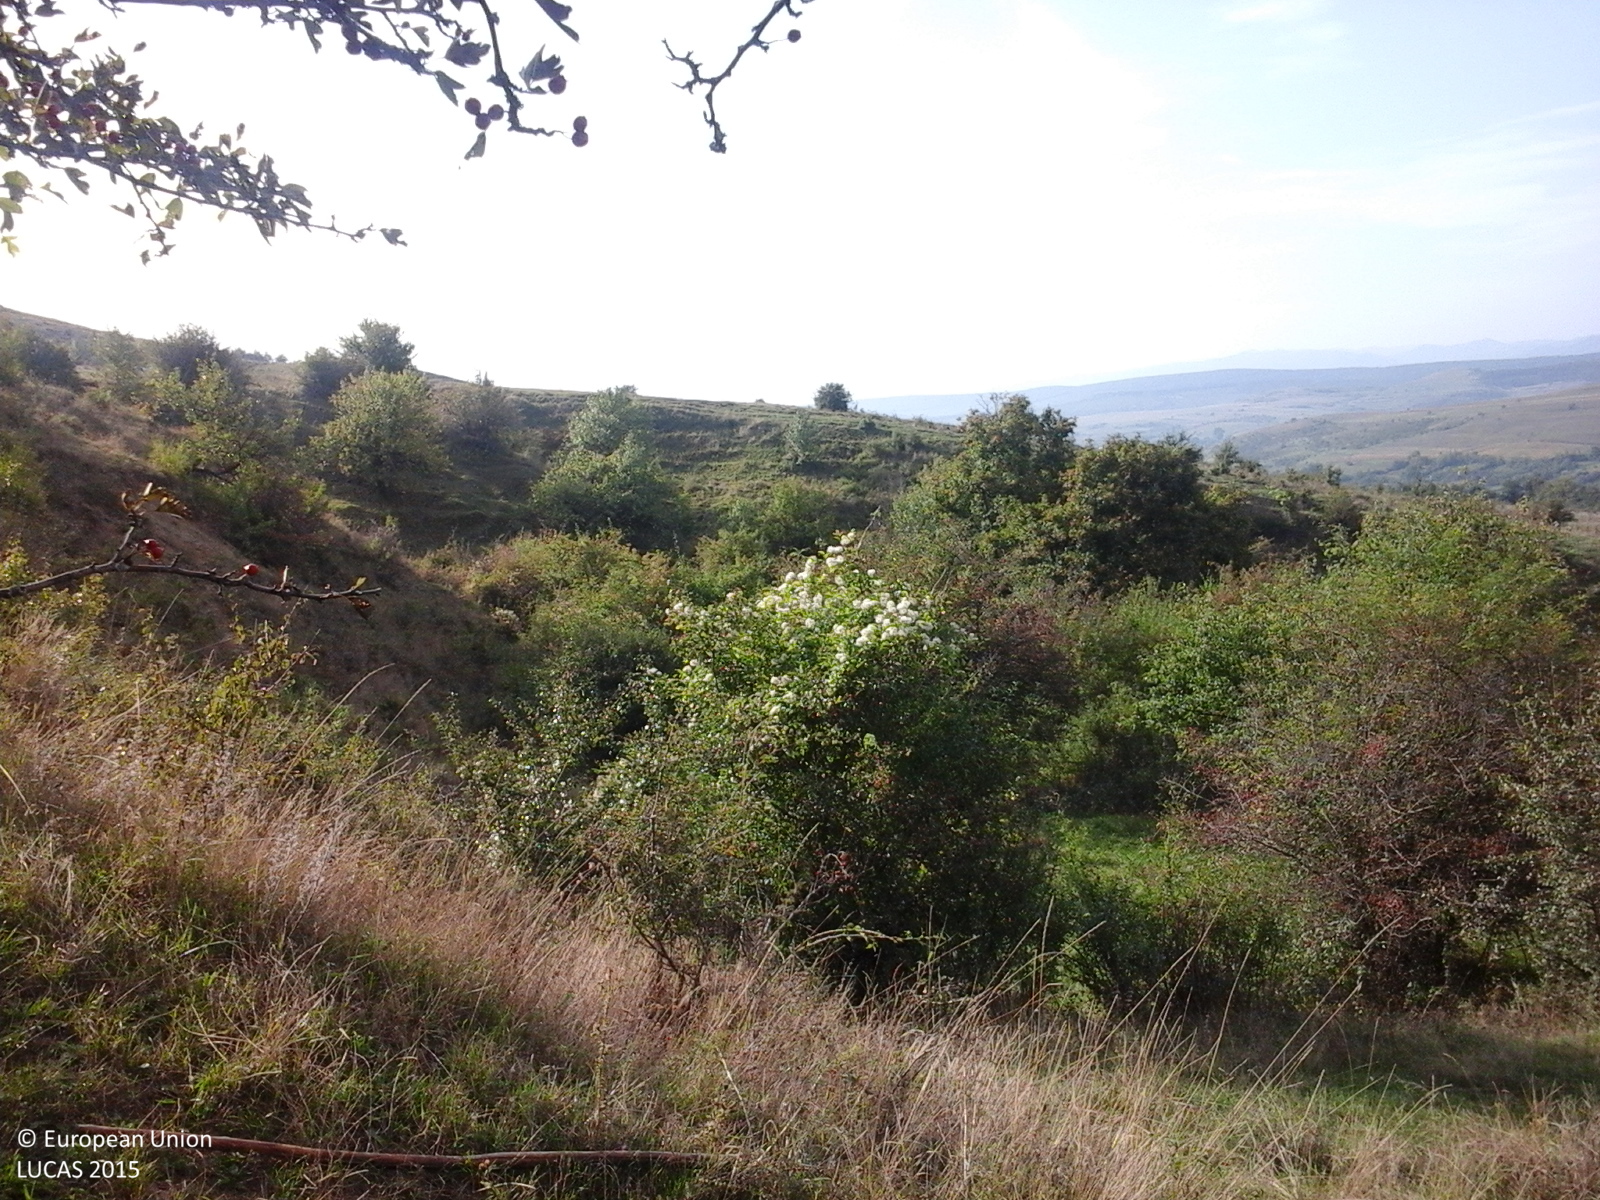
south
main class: Shrubland
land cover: Shrubland with sparse tree cover
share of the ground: > 75 %
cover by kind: herbaceous plants 85 %, shrubs 10 %, broadleaved forest trees 5 %
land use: Agriculture (excluding fallow land and kitchen gardens)
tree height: > 5 m
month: September
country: RO
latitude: 46.8593
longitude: 23.3547
